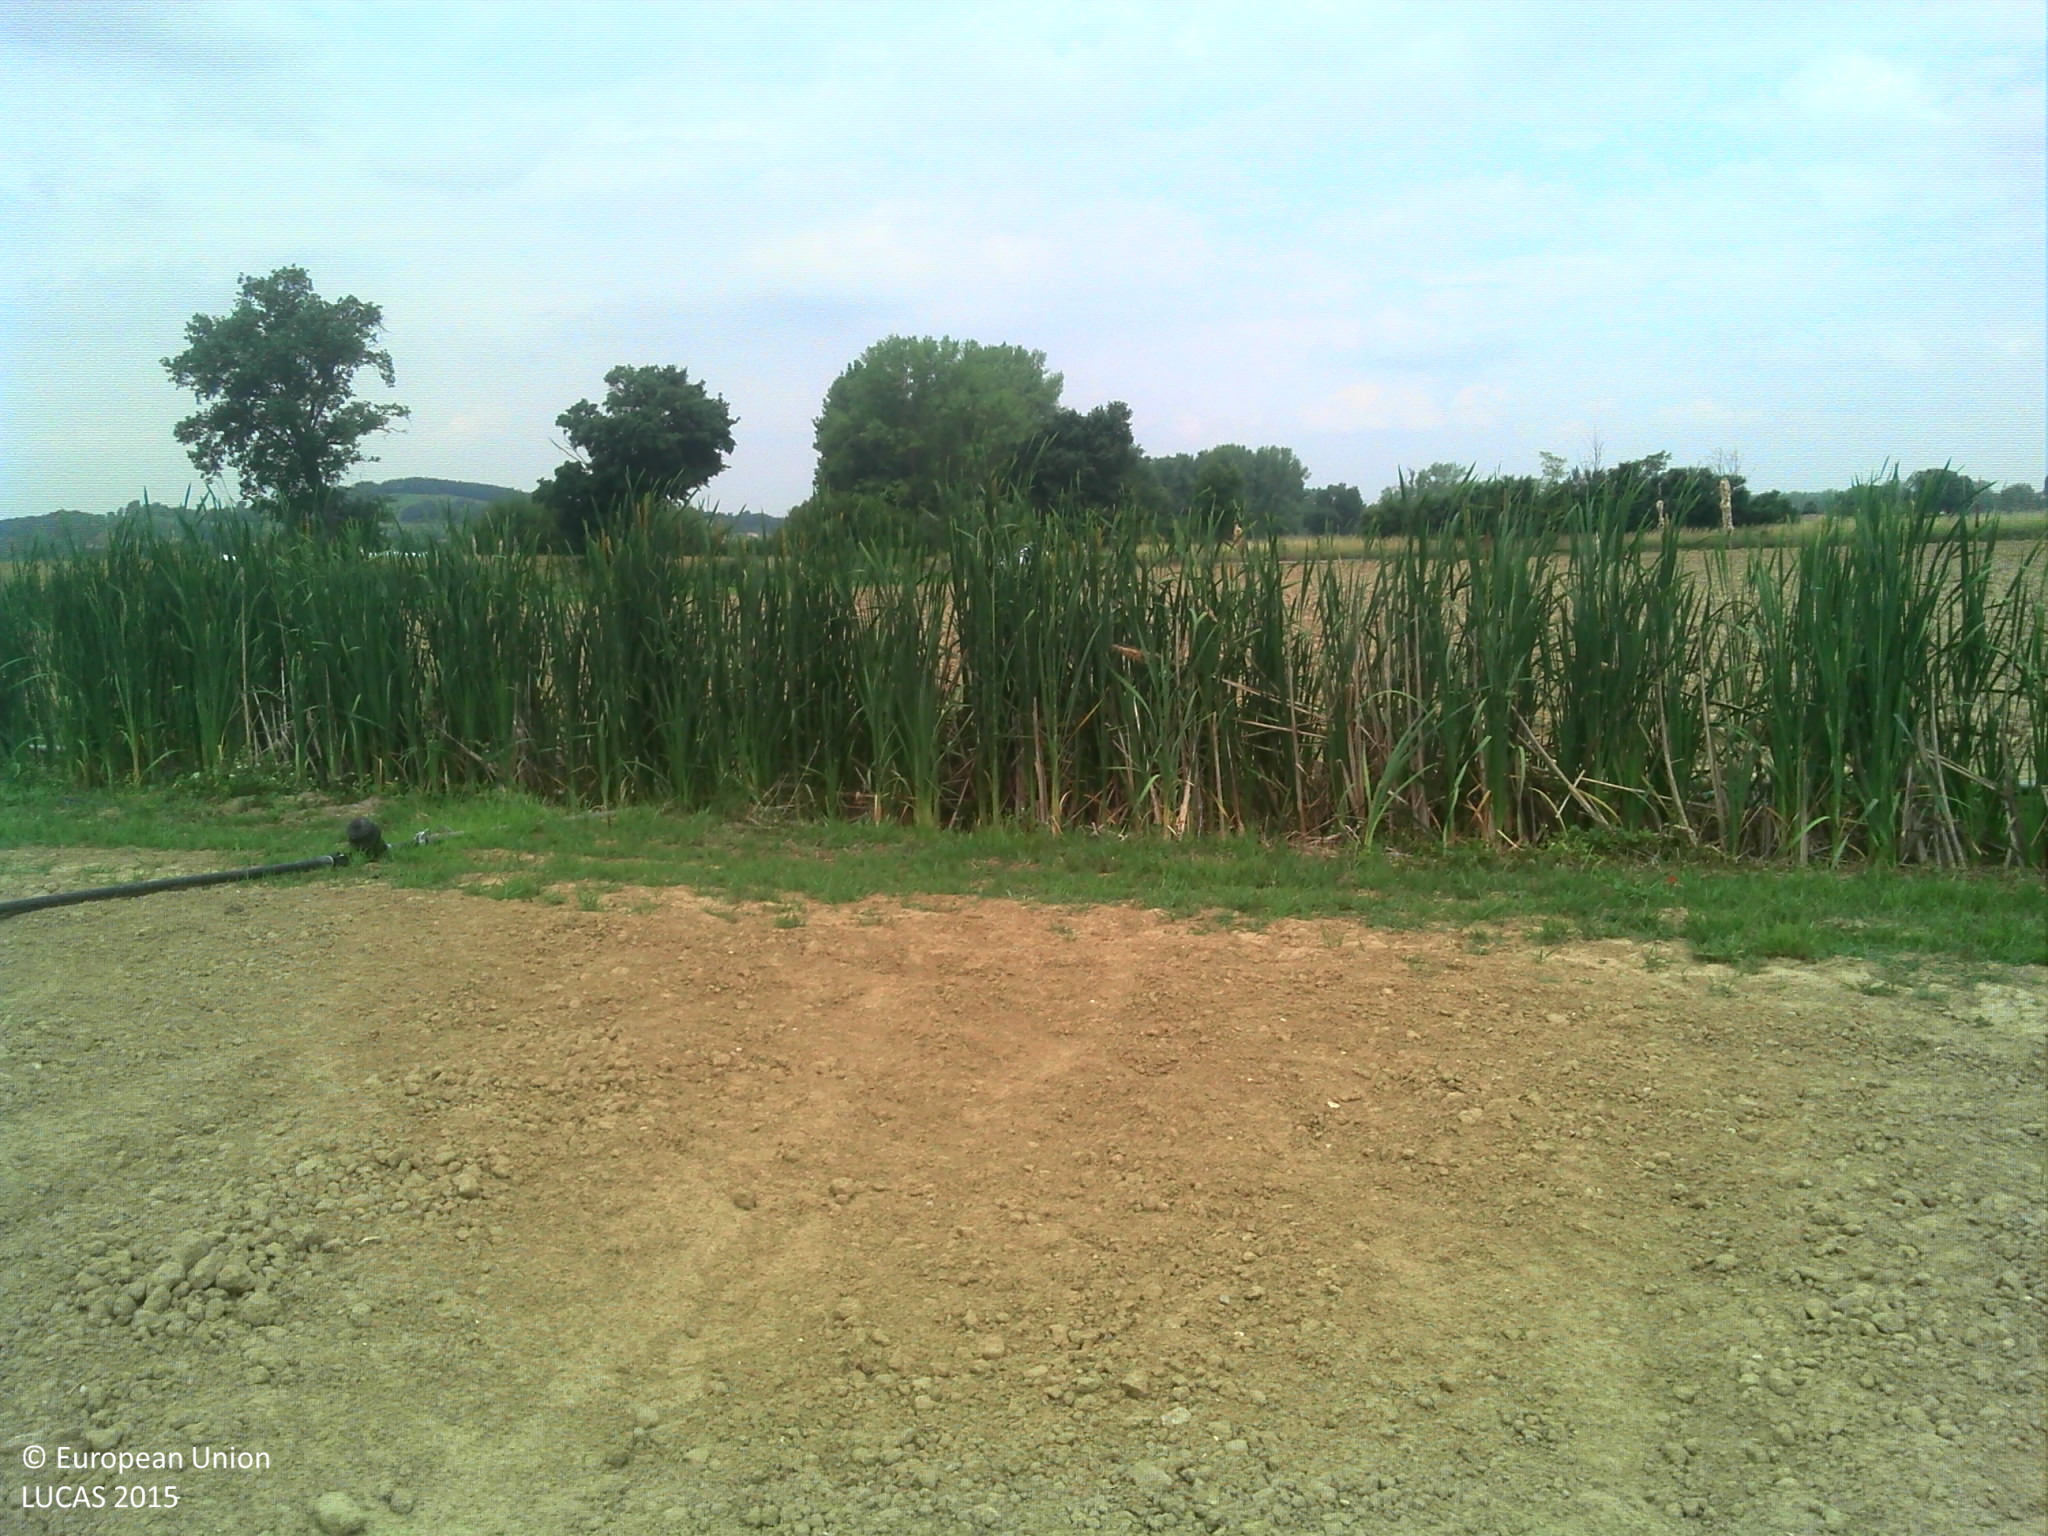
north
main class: Cropland
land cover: Other fresh vegetables
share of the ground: < 10 %
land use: Agriculture (excluding fallow land and kitchen gardens)
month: June
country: FR
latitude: 43.5991
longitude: 2.1392
